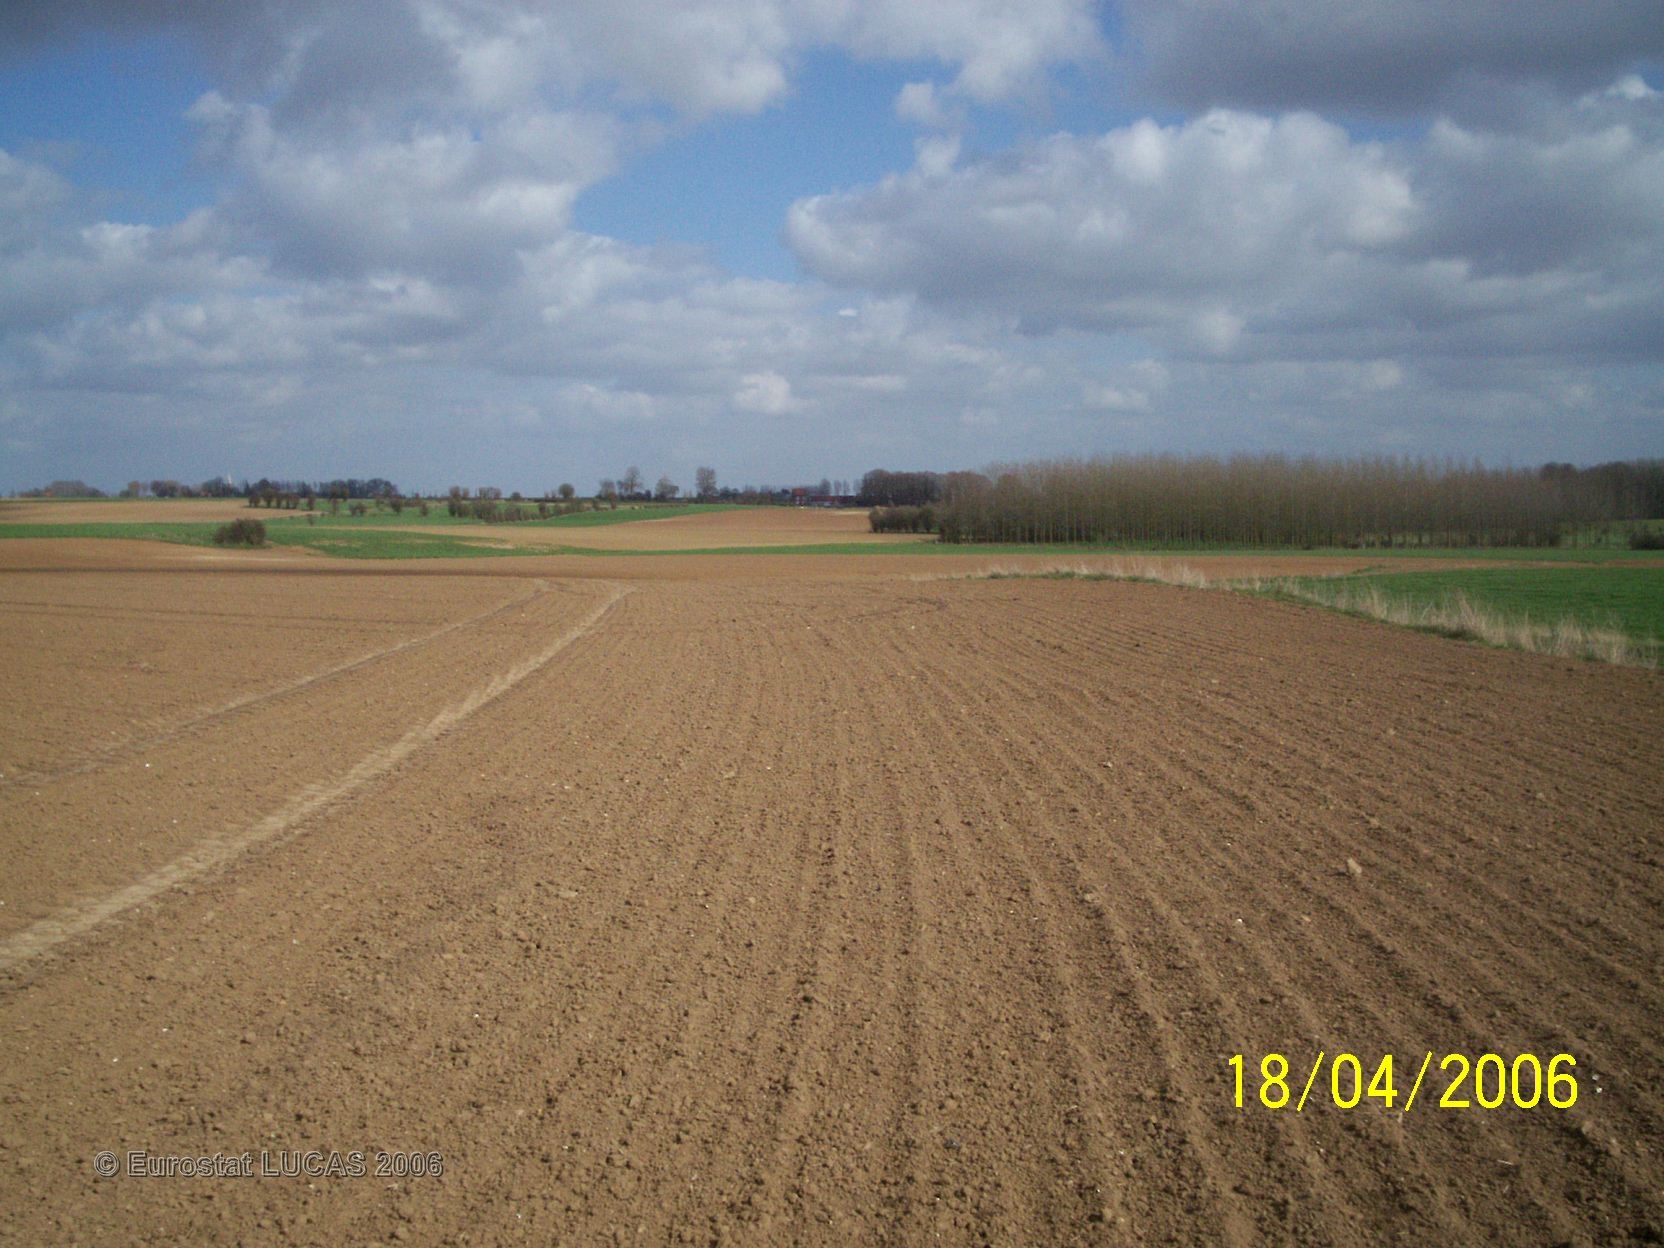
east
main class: Cropland
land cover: Dry pulses
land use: Agriculture (excluding fallow land and kitchen gardens)
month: April
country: FR
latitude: 50.3719
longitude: 2.5215
